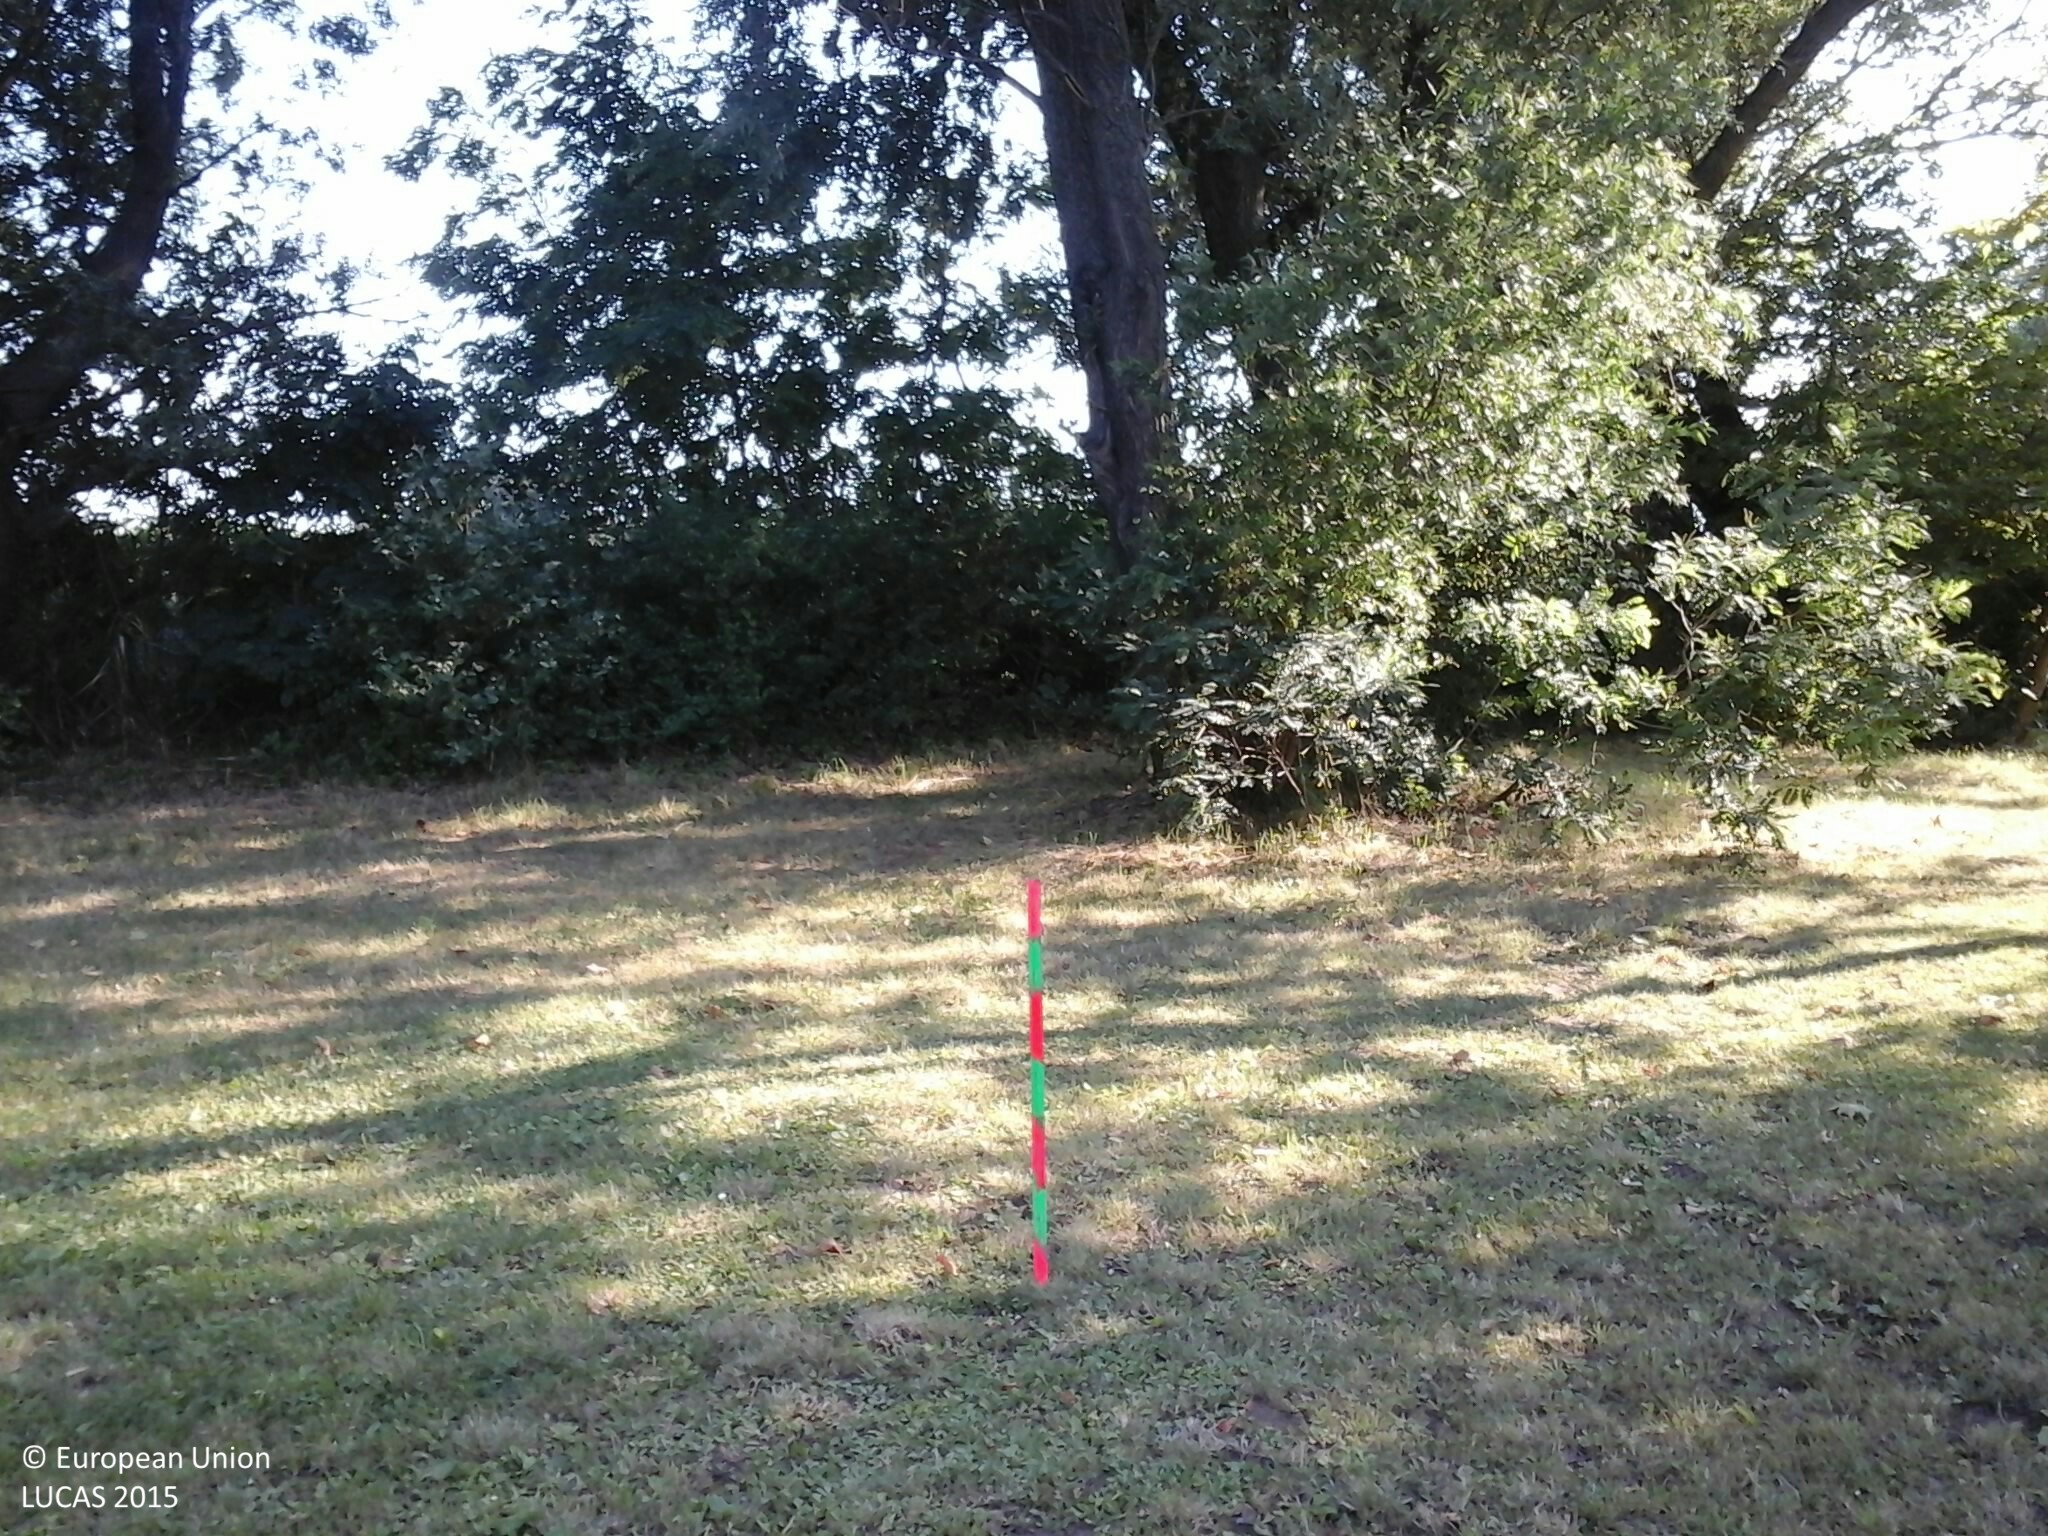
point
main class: Grassland
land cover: Grassland with sparse tree/shrub cover
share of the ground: > 75 %
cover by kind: herbaceous plants 90 %, broadleaved forest trees 5 %, shrubs 5 %
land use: Commerce
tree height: < 5 m
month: July
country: HU
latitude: 46.8828
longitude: 17.7629
